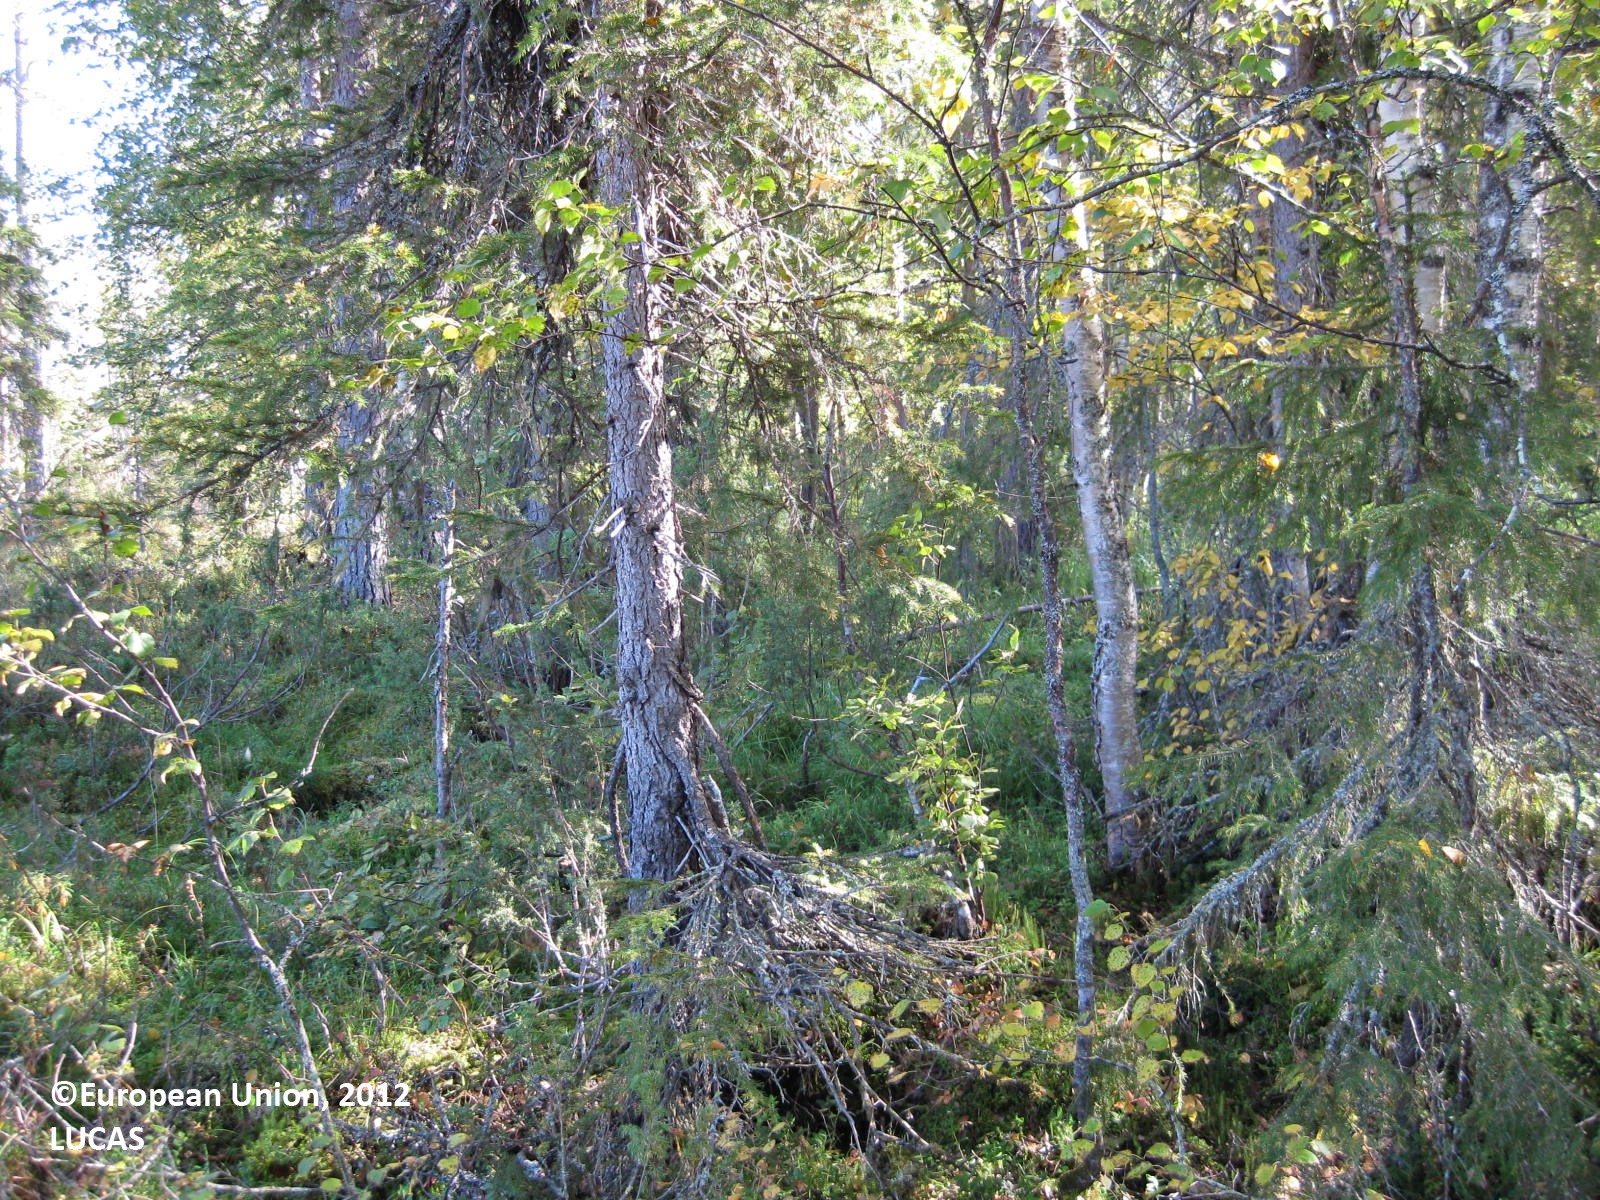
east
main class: Woodland
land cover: Other mixed woodland
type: boreal forest
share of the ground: > 75 %
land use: Forestry
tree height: > 5 m
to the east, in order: Other mixed woodland; Ditches and canals; Other mixed woodland; Grassland with sparse tree/shrub cover; Ditches and canals; Grassland with sparse tree/shrub cover; Ditches and canals; Grassland without tree/shrub cover; Other coniferous woodland; Pine dominated coniferous woodland; Ponds and wetlands
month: August
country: FI
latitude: 65.9111
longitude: 28.6708
